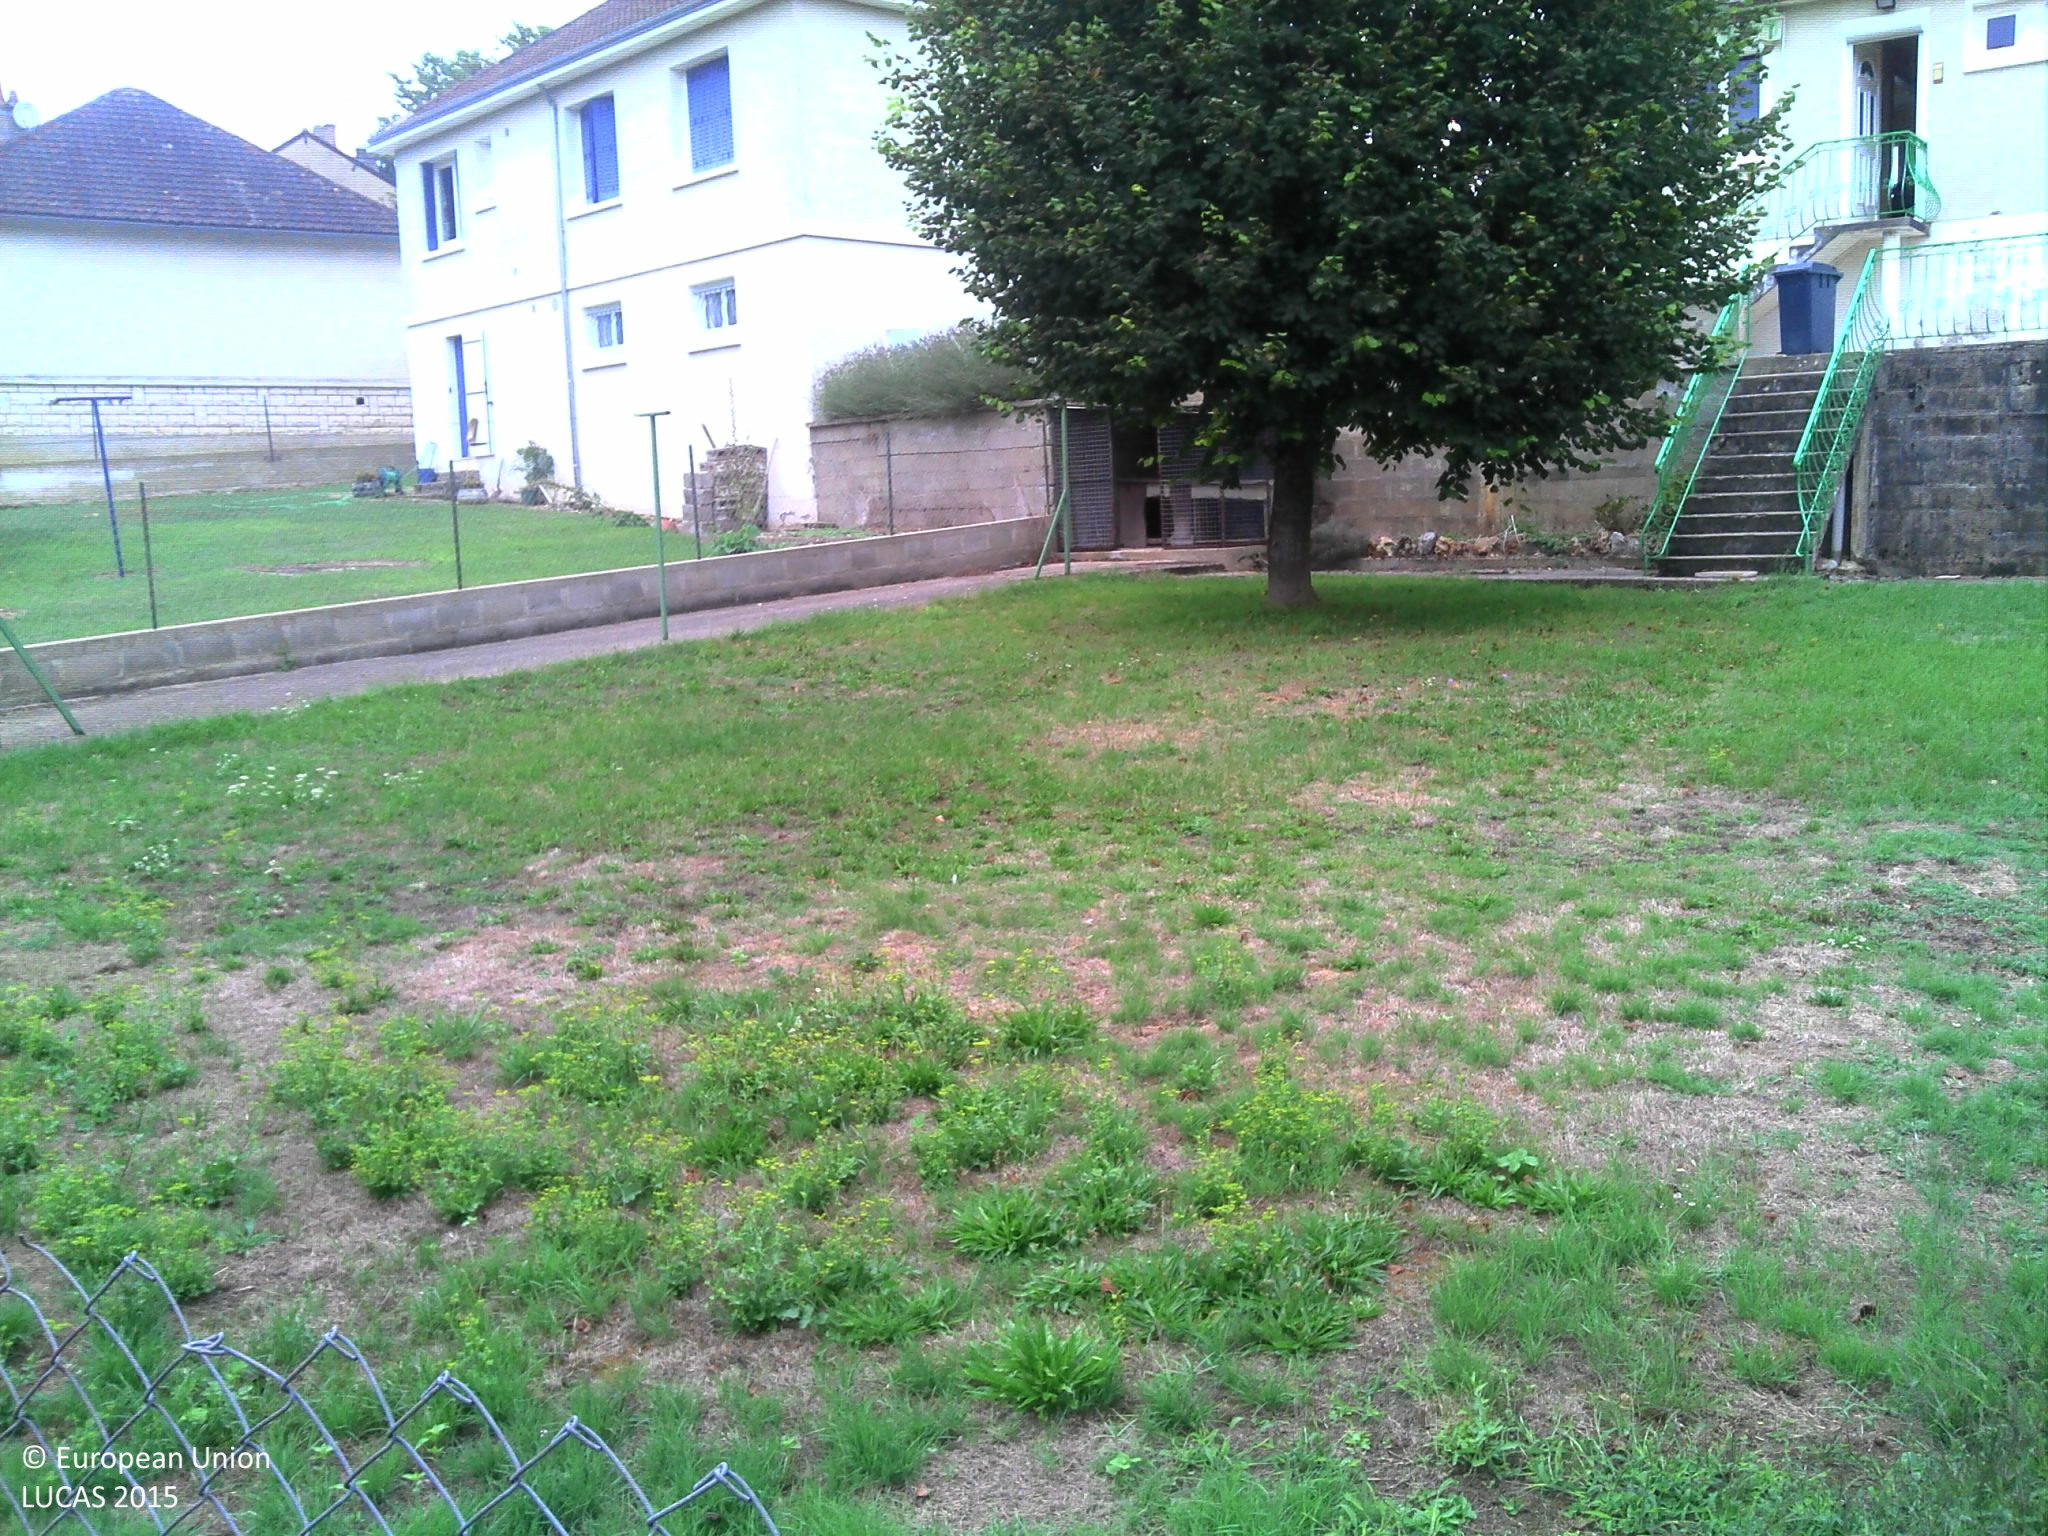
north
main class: Grassland
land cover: Grassland with sparse tree/shrub cover
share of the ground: > 75 %
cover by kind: herbaceous plants 55 %, unconsolidated bare surface 40 %, broadleaved forest trees 5 %
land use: Residential
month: September
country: FR
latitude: 46.8476
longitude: 1.5301
